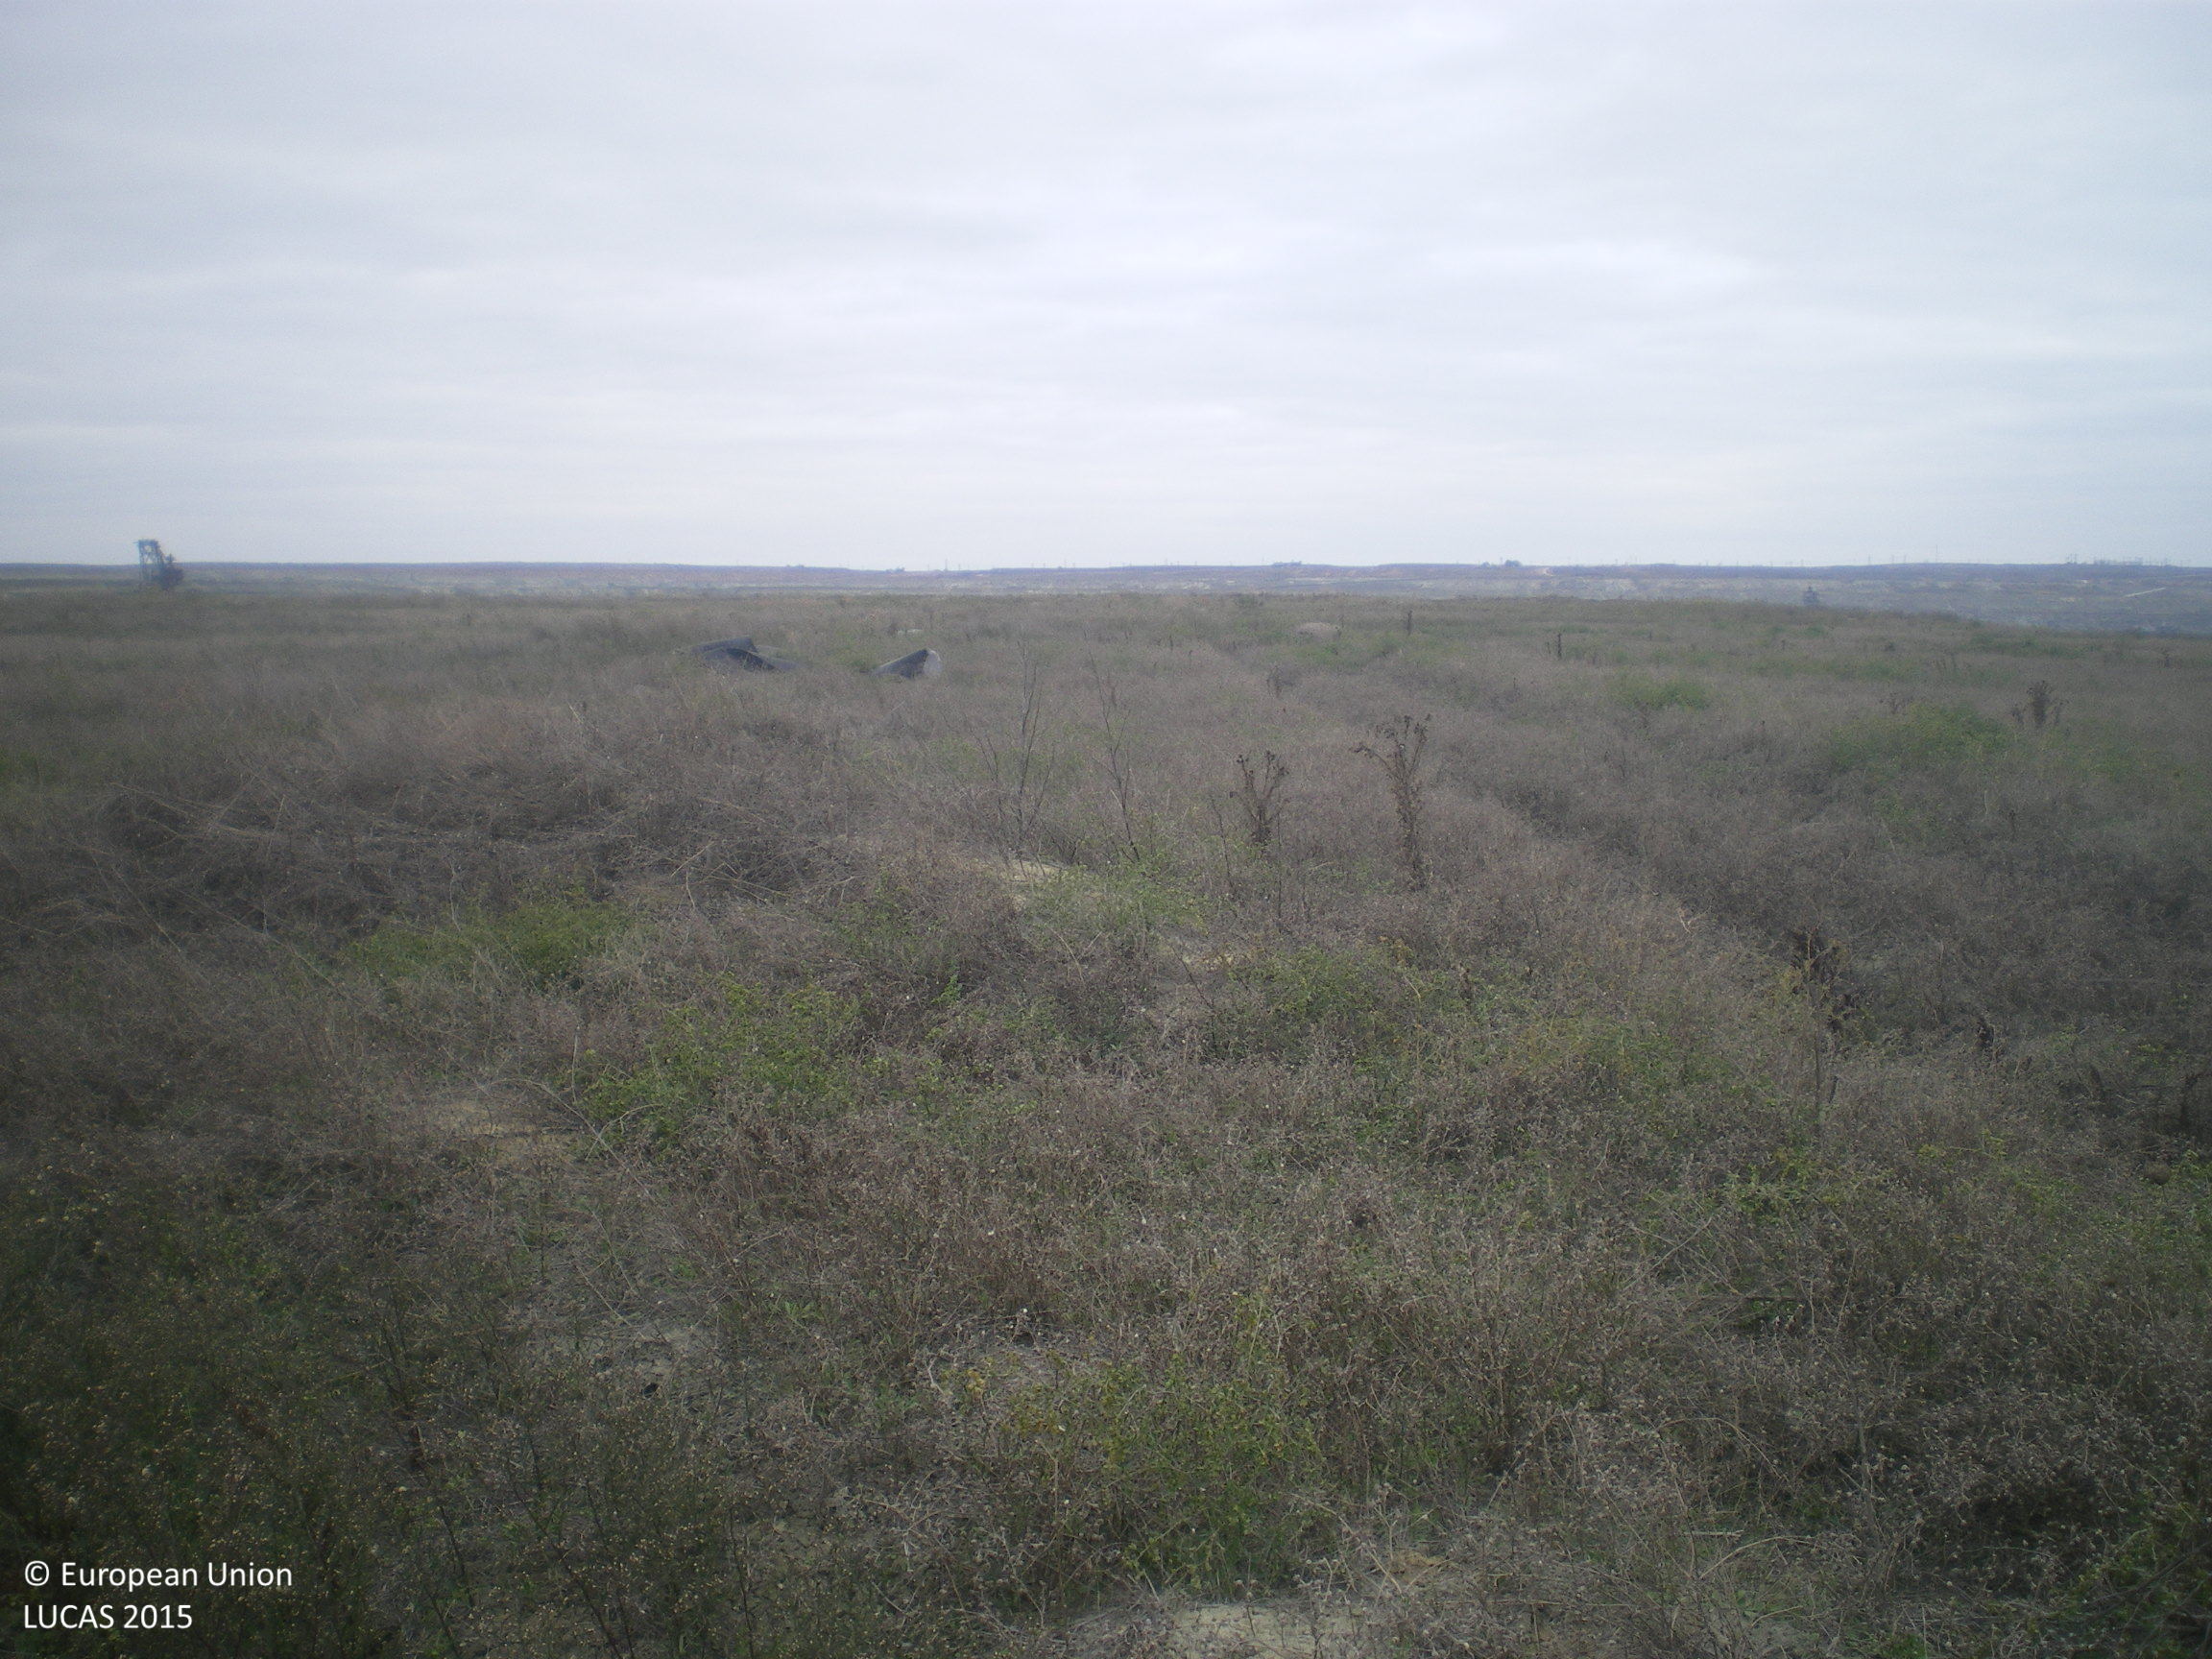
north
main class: Grassland
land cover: Grassland without tree/shrub cover
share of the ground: > 75 %
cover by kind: herbaceous plants 100 %
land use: Mining and quarrying
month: October
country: BG
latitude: 42.2204
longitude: 25.9835
